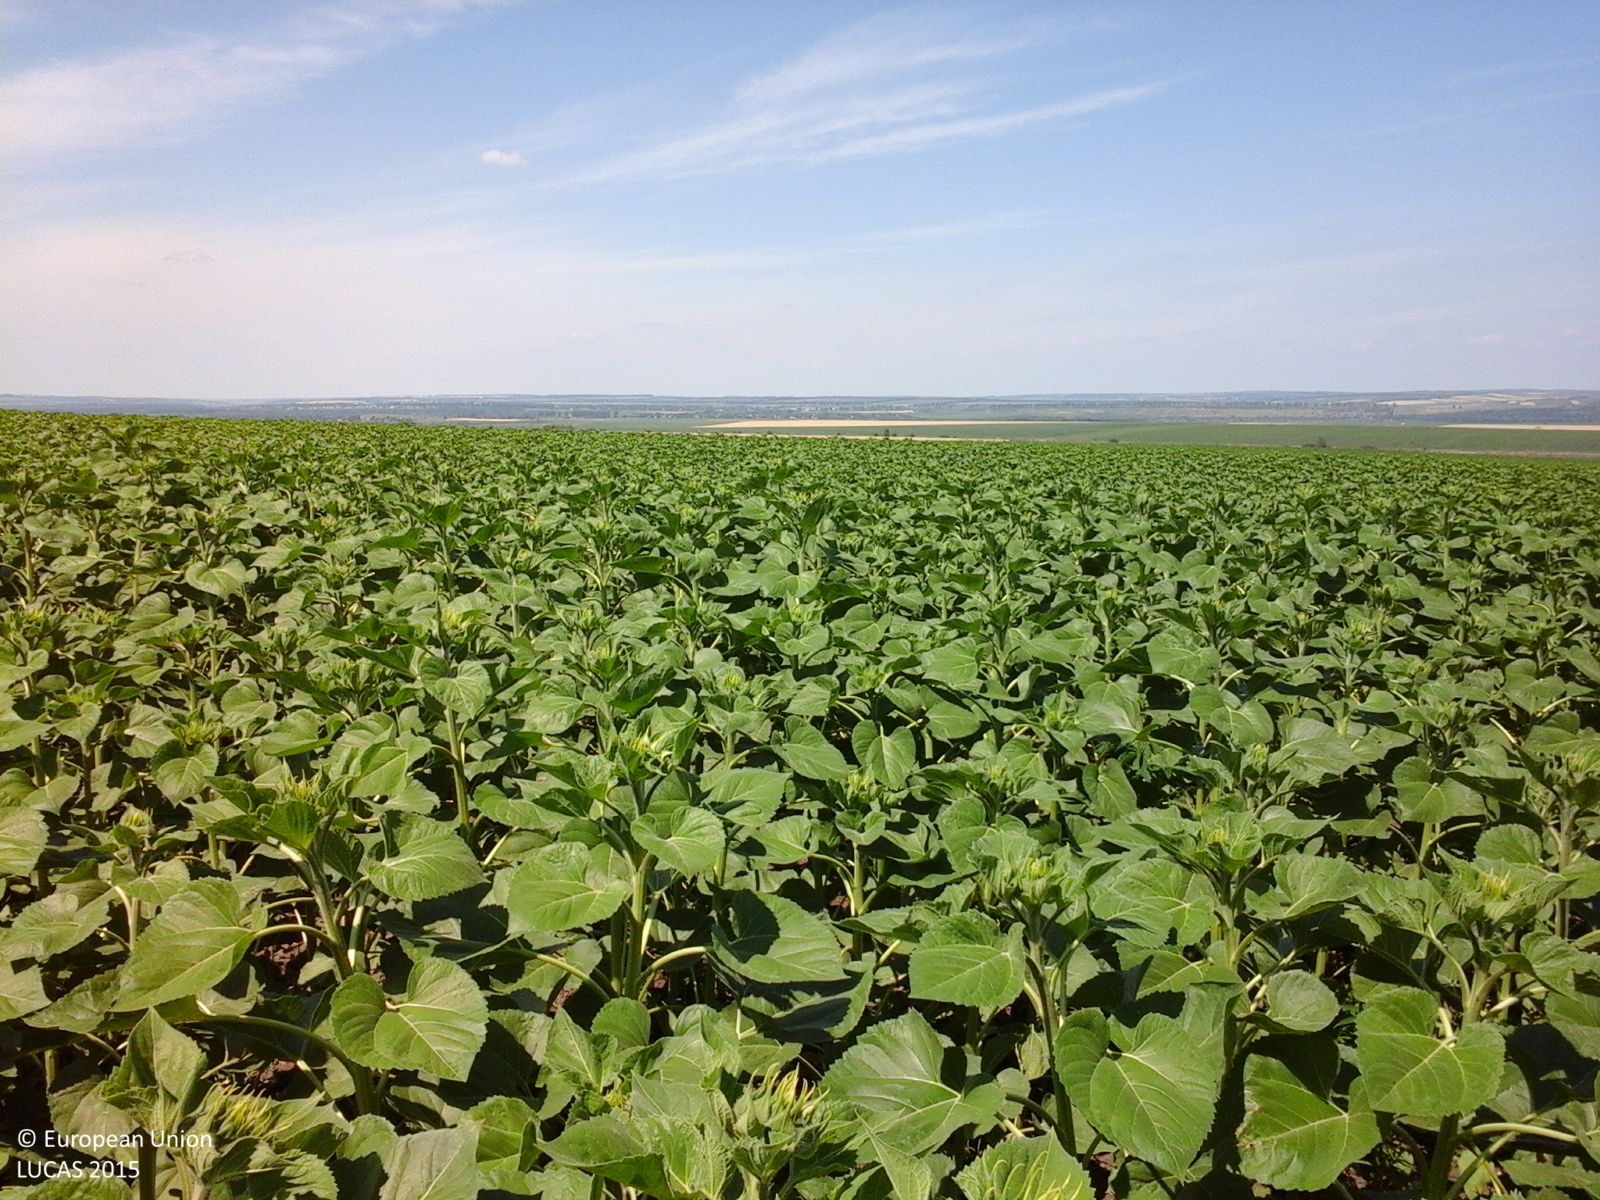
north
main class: Cropland
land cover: Sunflower
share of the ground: > 75 %
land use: Agriculture (excluding fallow land and kitchen gardens)
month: June
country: RO
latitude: 48.0881
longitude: 26.9822
